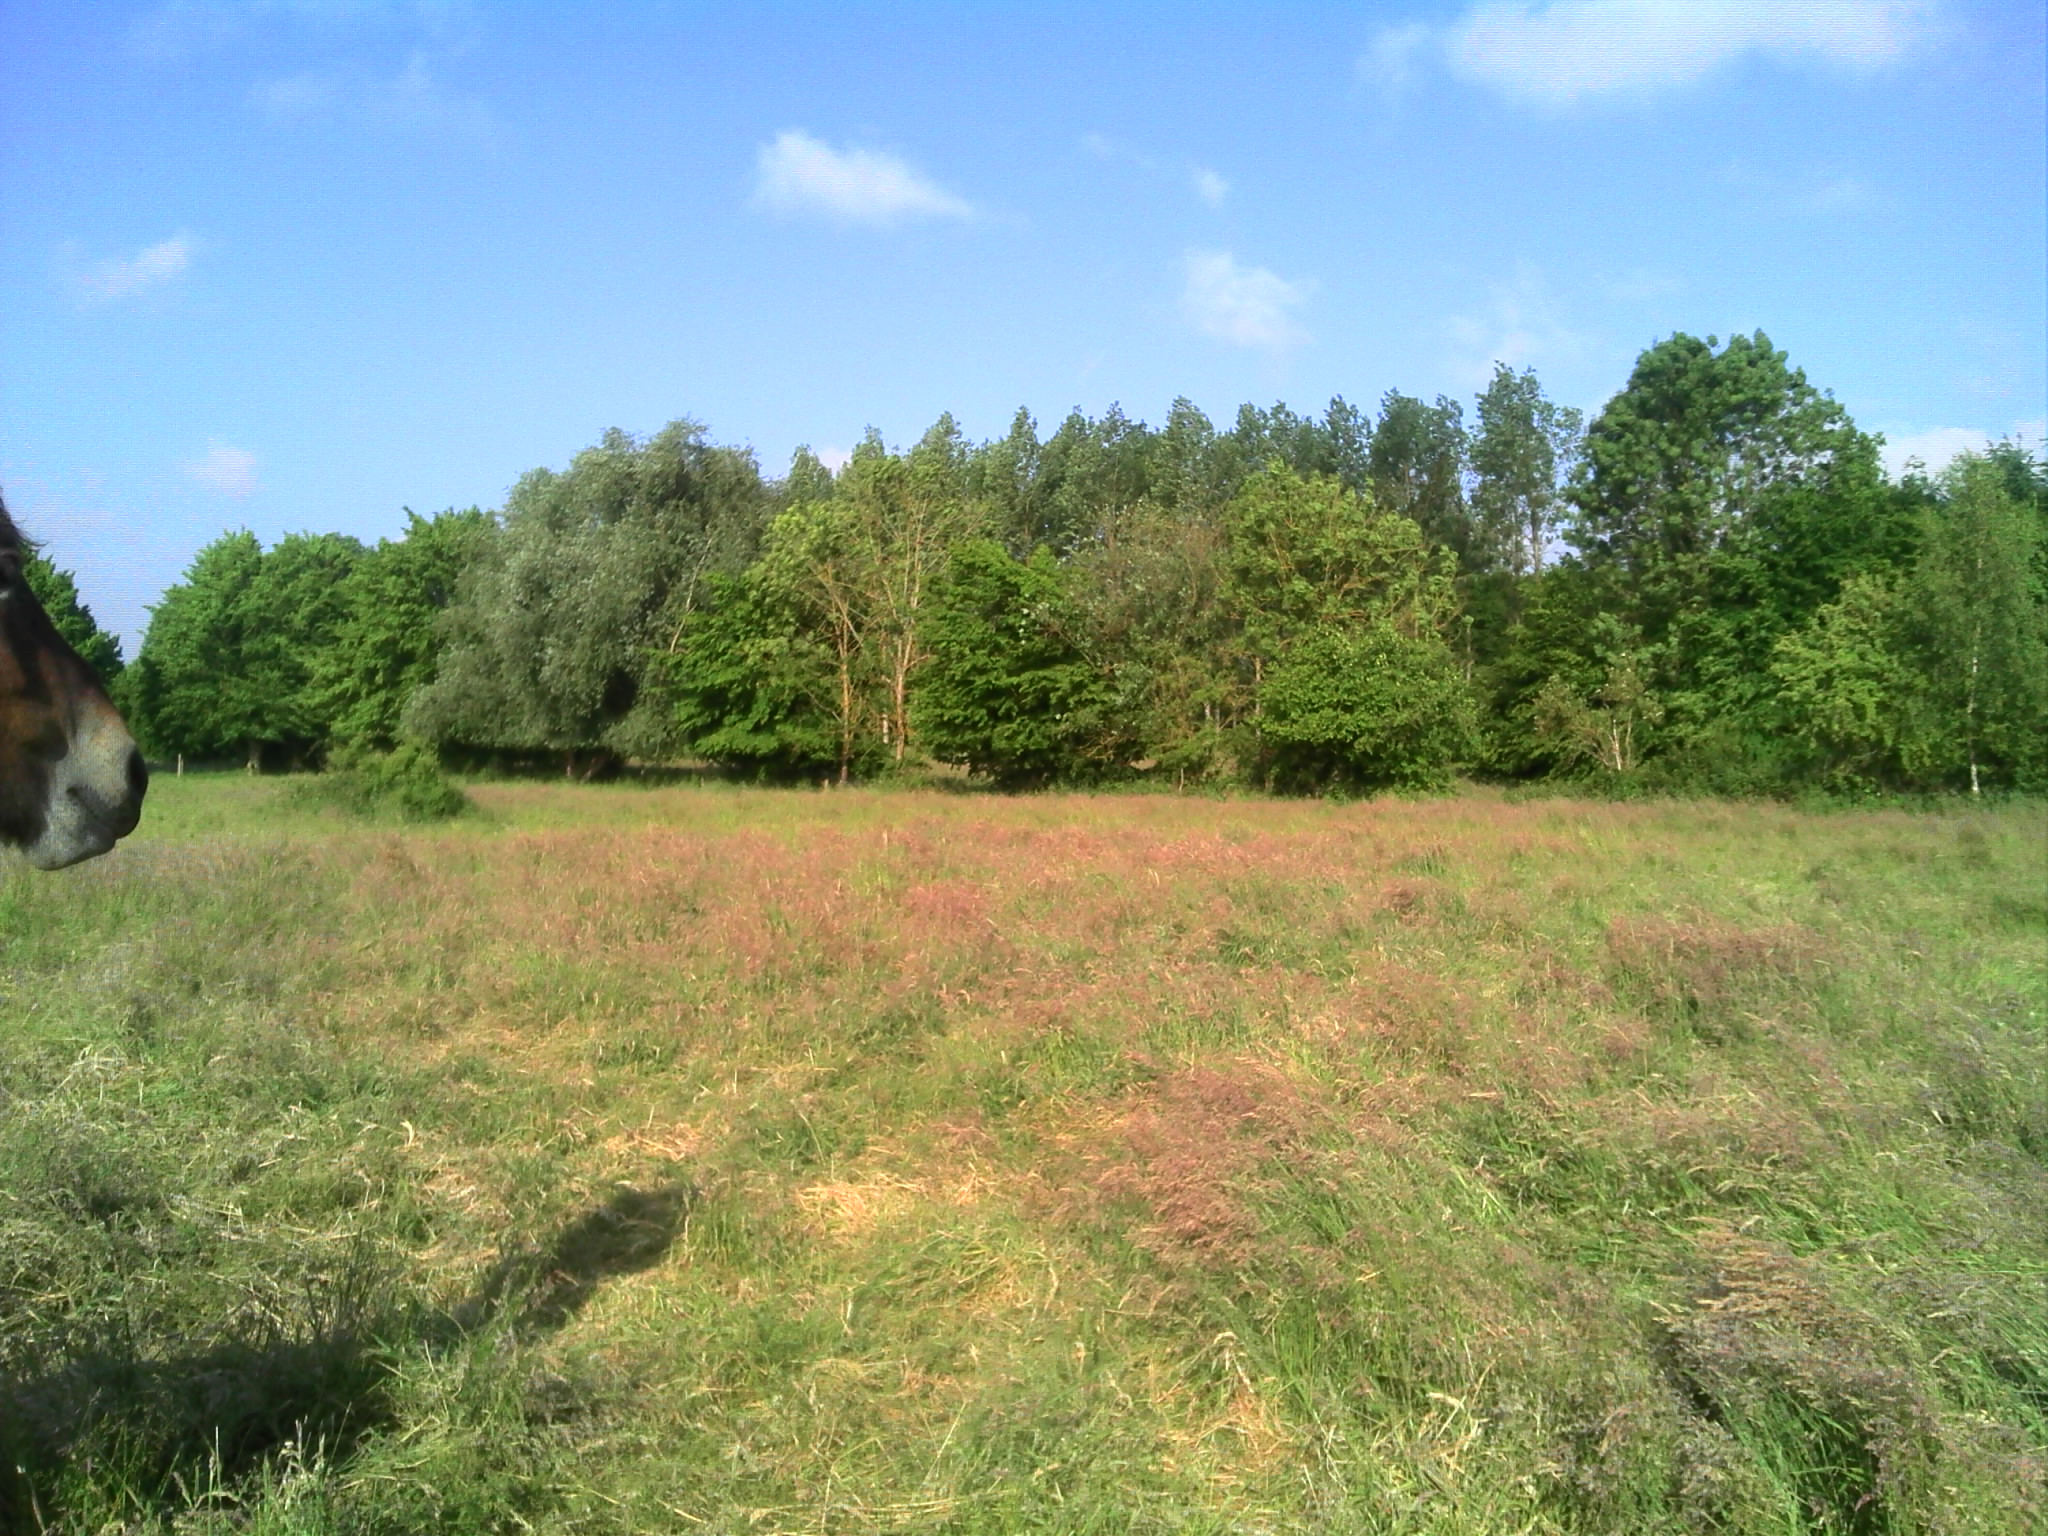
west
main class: Grassland
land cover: Grassland without tree/shrub cover
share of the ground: > 75 %
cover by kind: herbaceous plants 100 %
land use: Agriculture (excluding fallow land and kitchen gardens)
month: June
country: BE
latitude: 50.3903
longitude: 4.8065
